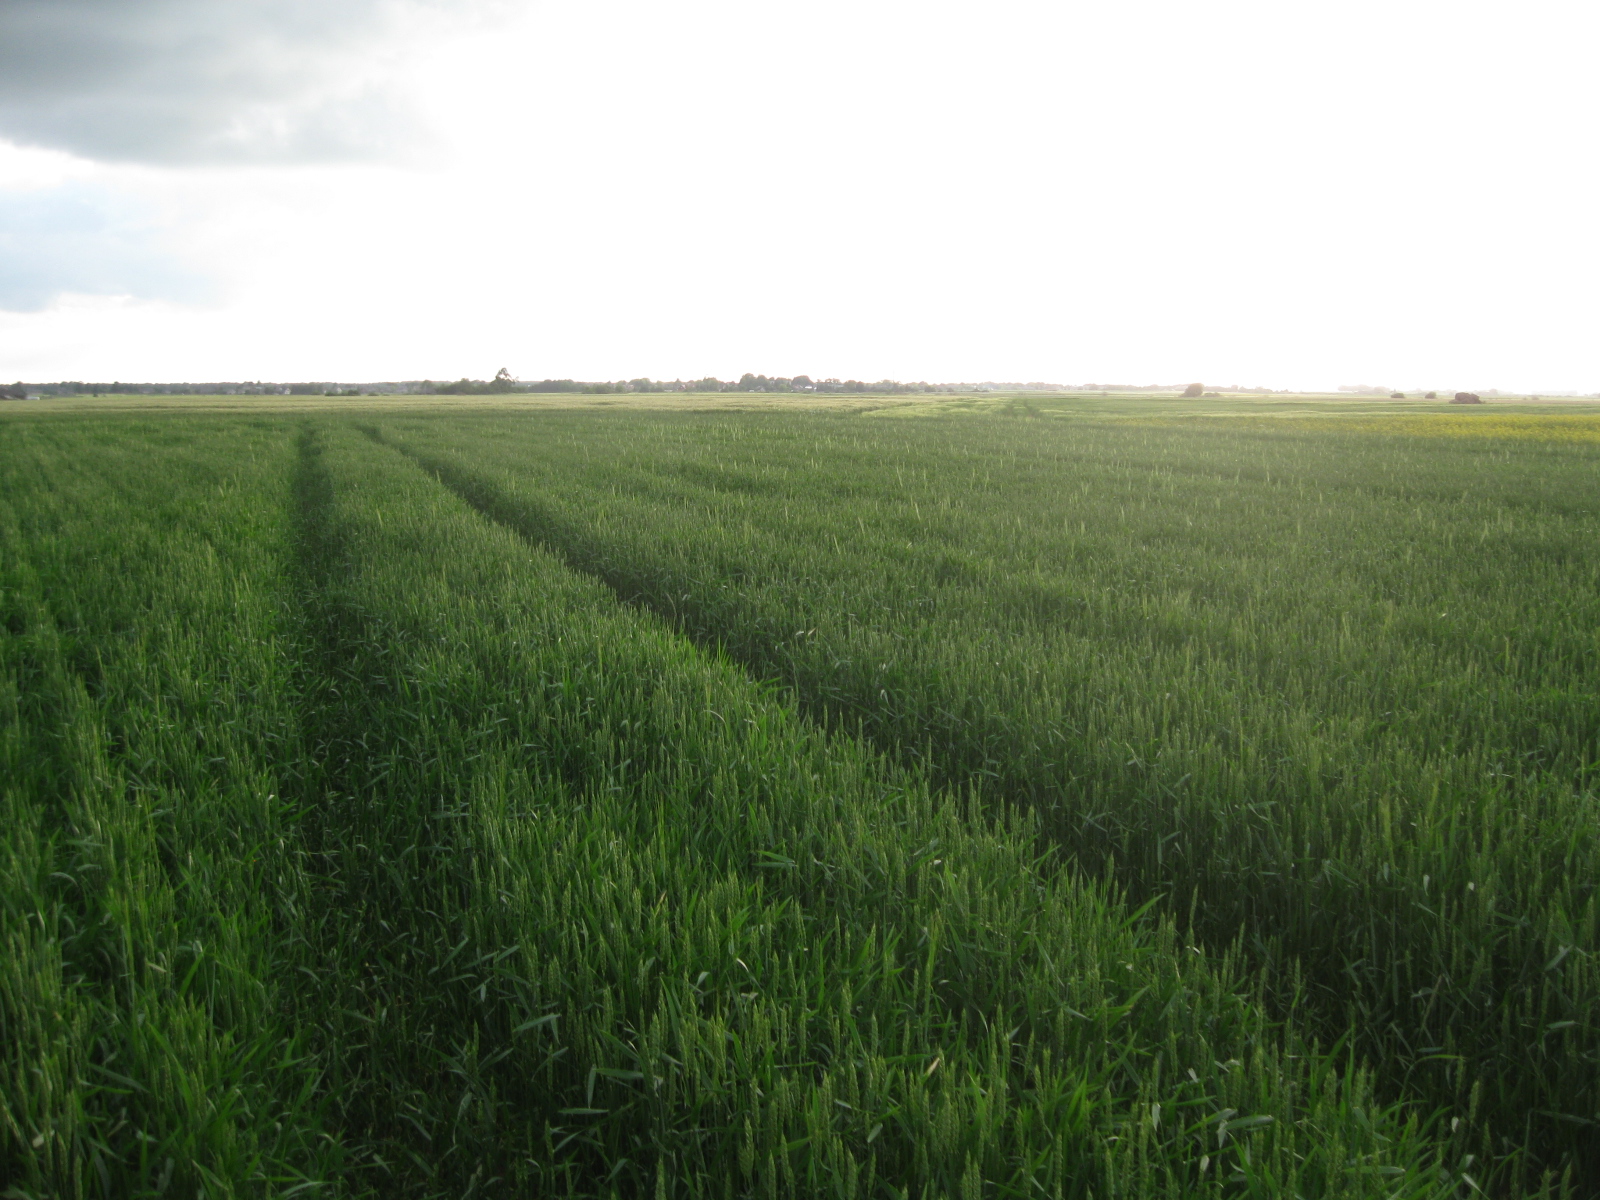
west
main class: Cropland
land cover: Common wheat
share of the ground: > 75 %
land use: Agriculture (excluding fallow land and kitchen gardens)
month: June
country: LT
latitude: 55.4671
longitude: 24.1866
